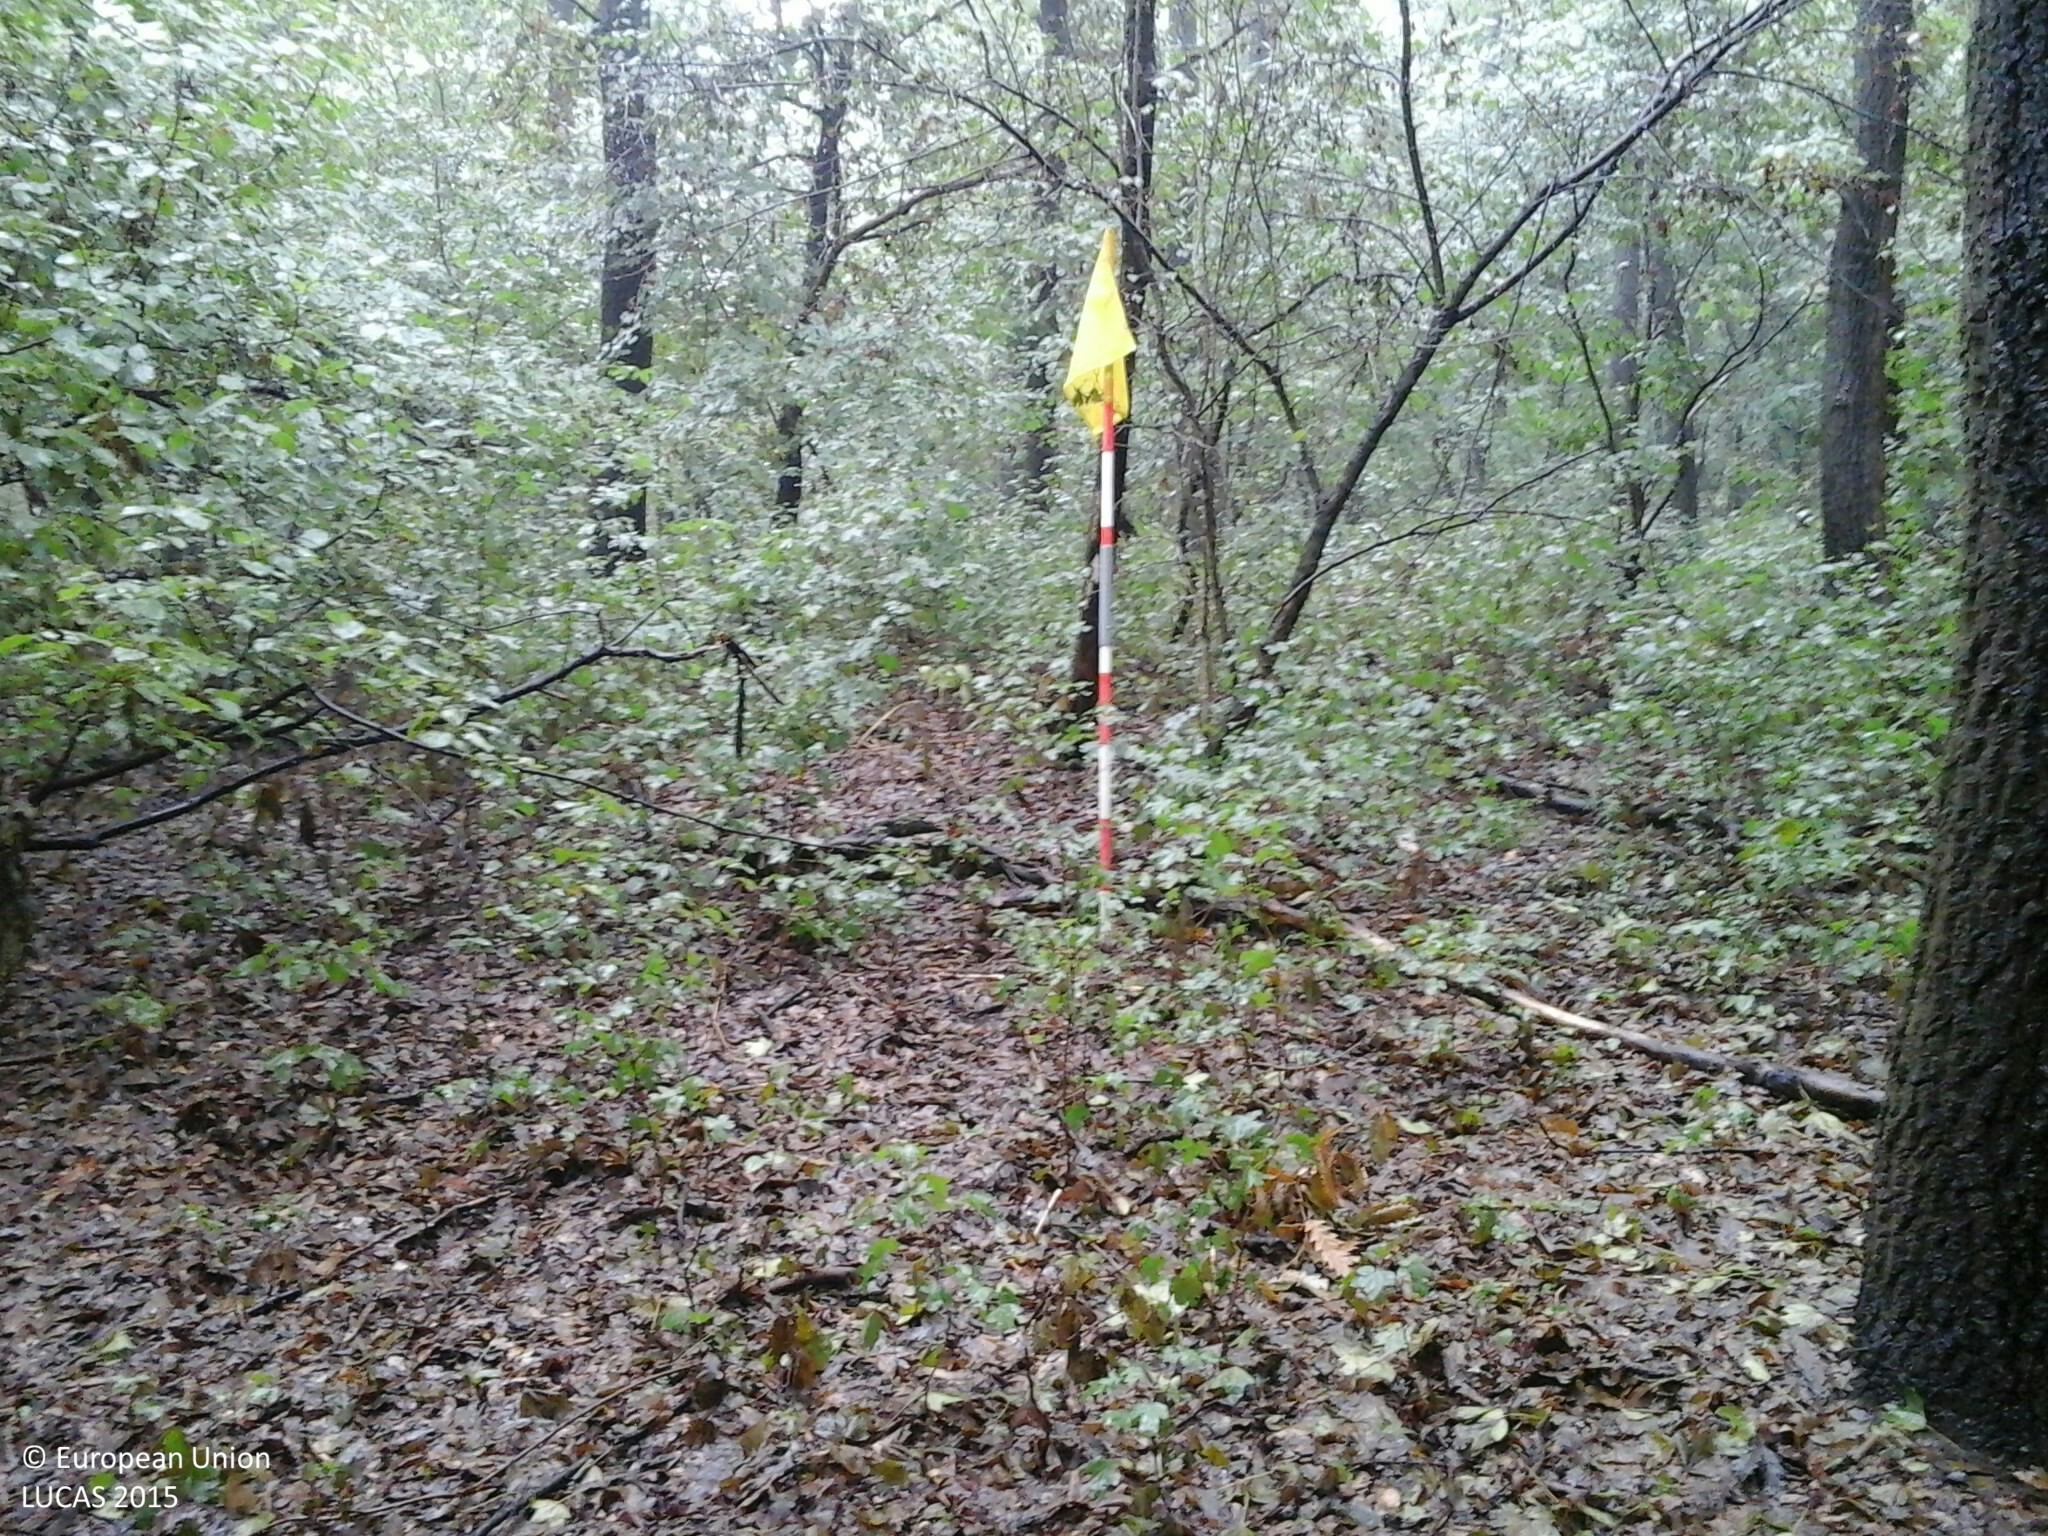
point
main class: Woodland
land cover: Broadleaved woodland
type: acidophilous oak and oak-birch forest
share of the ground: > 75 %
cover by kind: broadleaved forest trees 100 %
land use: Forestry
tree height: > 5 m
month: August
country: HU
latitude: 47.9723
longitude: 20.7115
